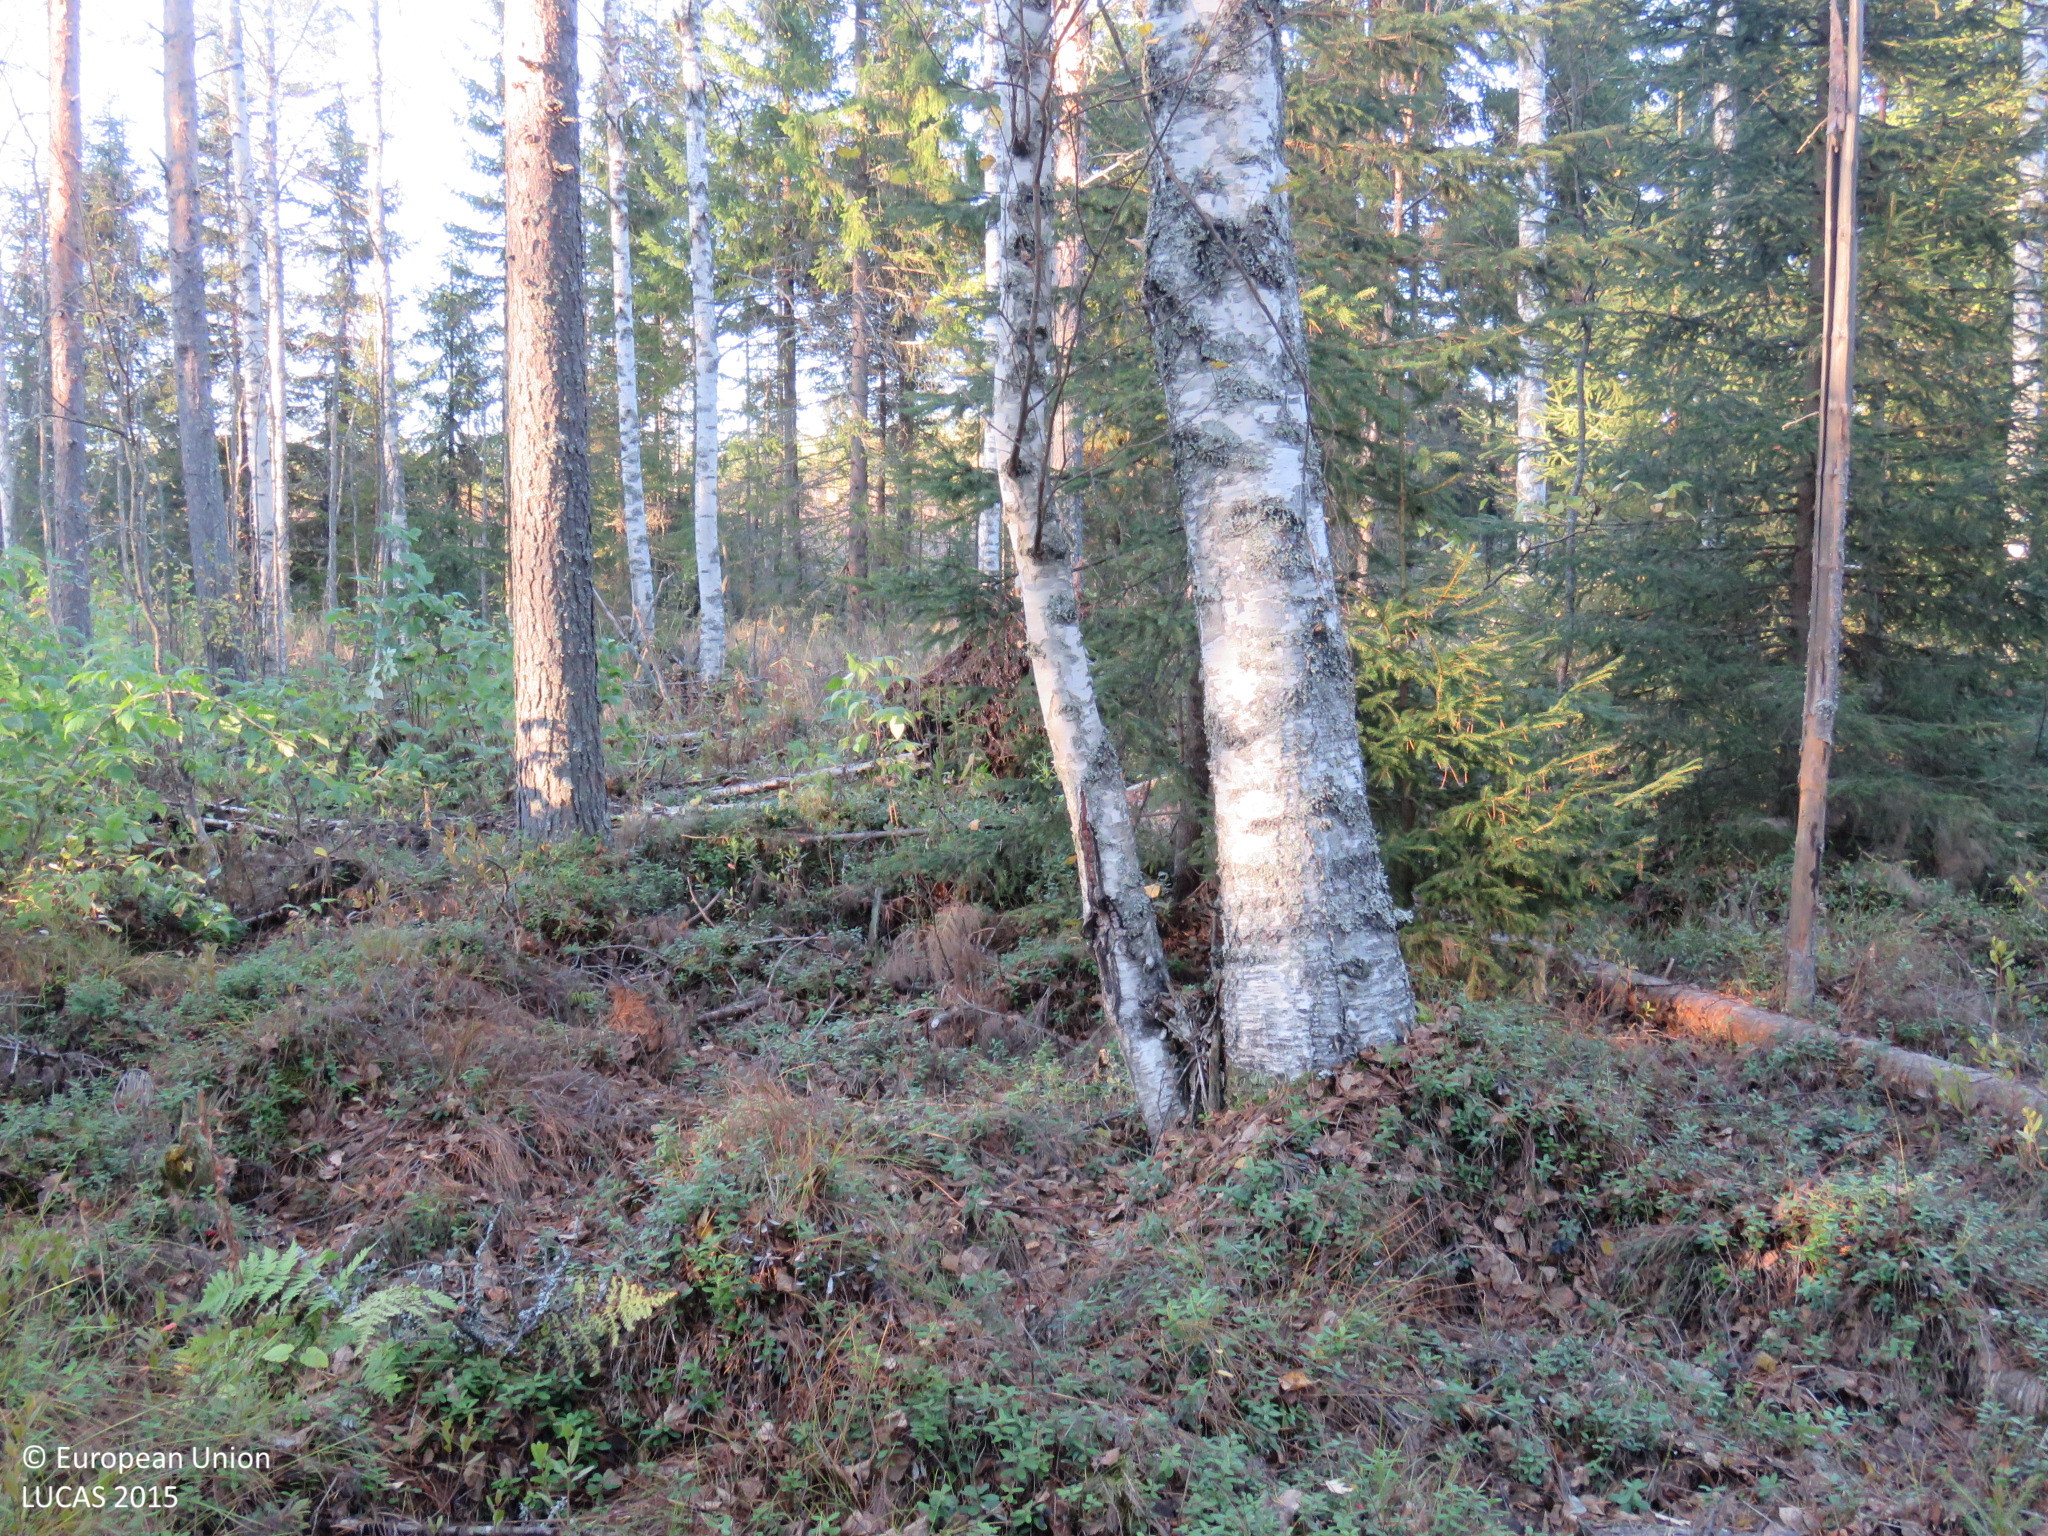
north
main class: Woodland
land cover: Other mixed woodland
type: mire and swamp forests
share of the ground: > 75 %
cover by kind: coniferous forest trees 50 %, broadleaved forest trees 25 %, shrubs 15 %, herbaceous plants 10 %
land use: Forestry
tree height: > 5 m
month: October
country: FI
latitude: 64.3601
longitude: 27.3528
